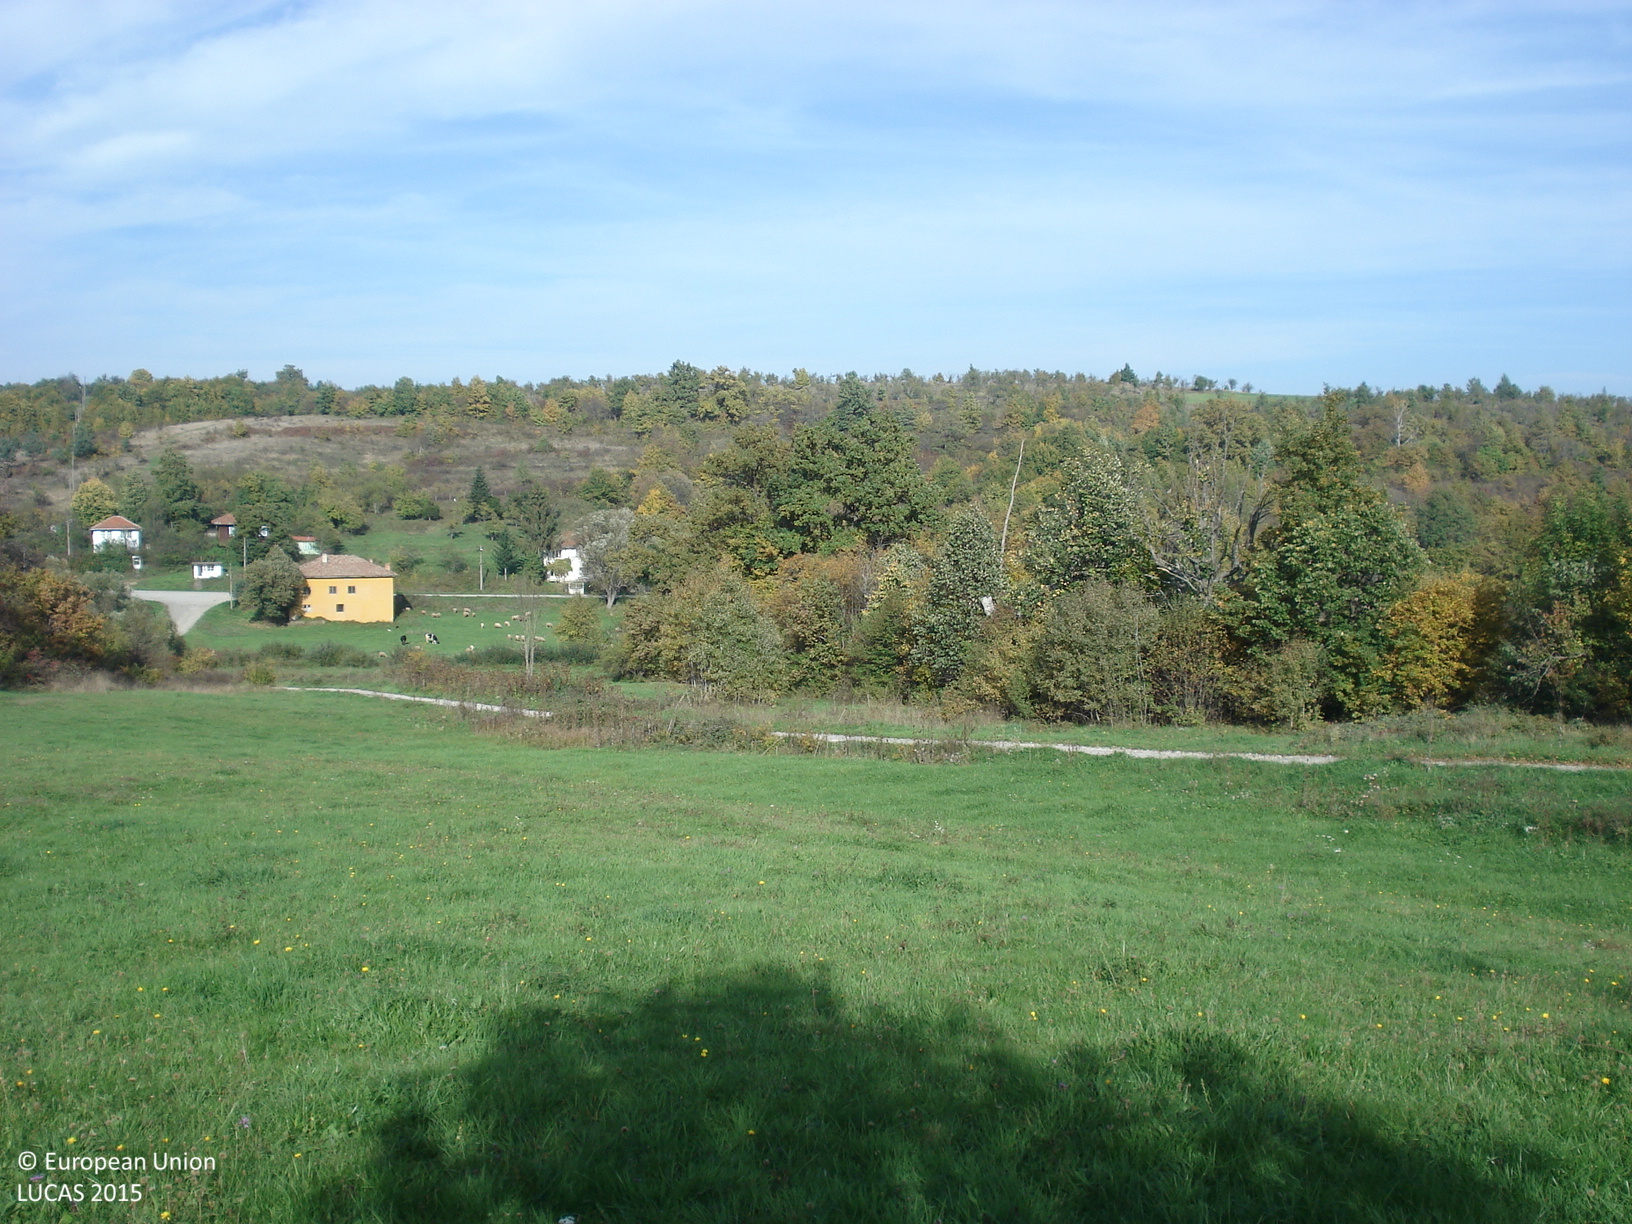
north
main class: Woodland
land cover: Broadleaved woodland
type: mesophytic deciduous forest
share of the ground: > 75 %
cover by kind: broadleaved forest trees 80 %, herbaceous plants 15 %, shrubs 5 %
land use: Semi-natural and natural areas not in use
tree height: < 5 m
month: October
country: BG
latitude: 42.9006
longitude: 26.0947
